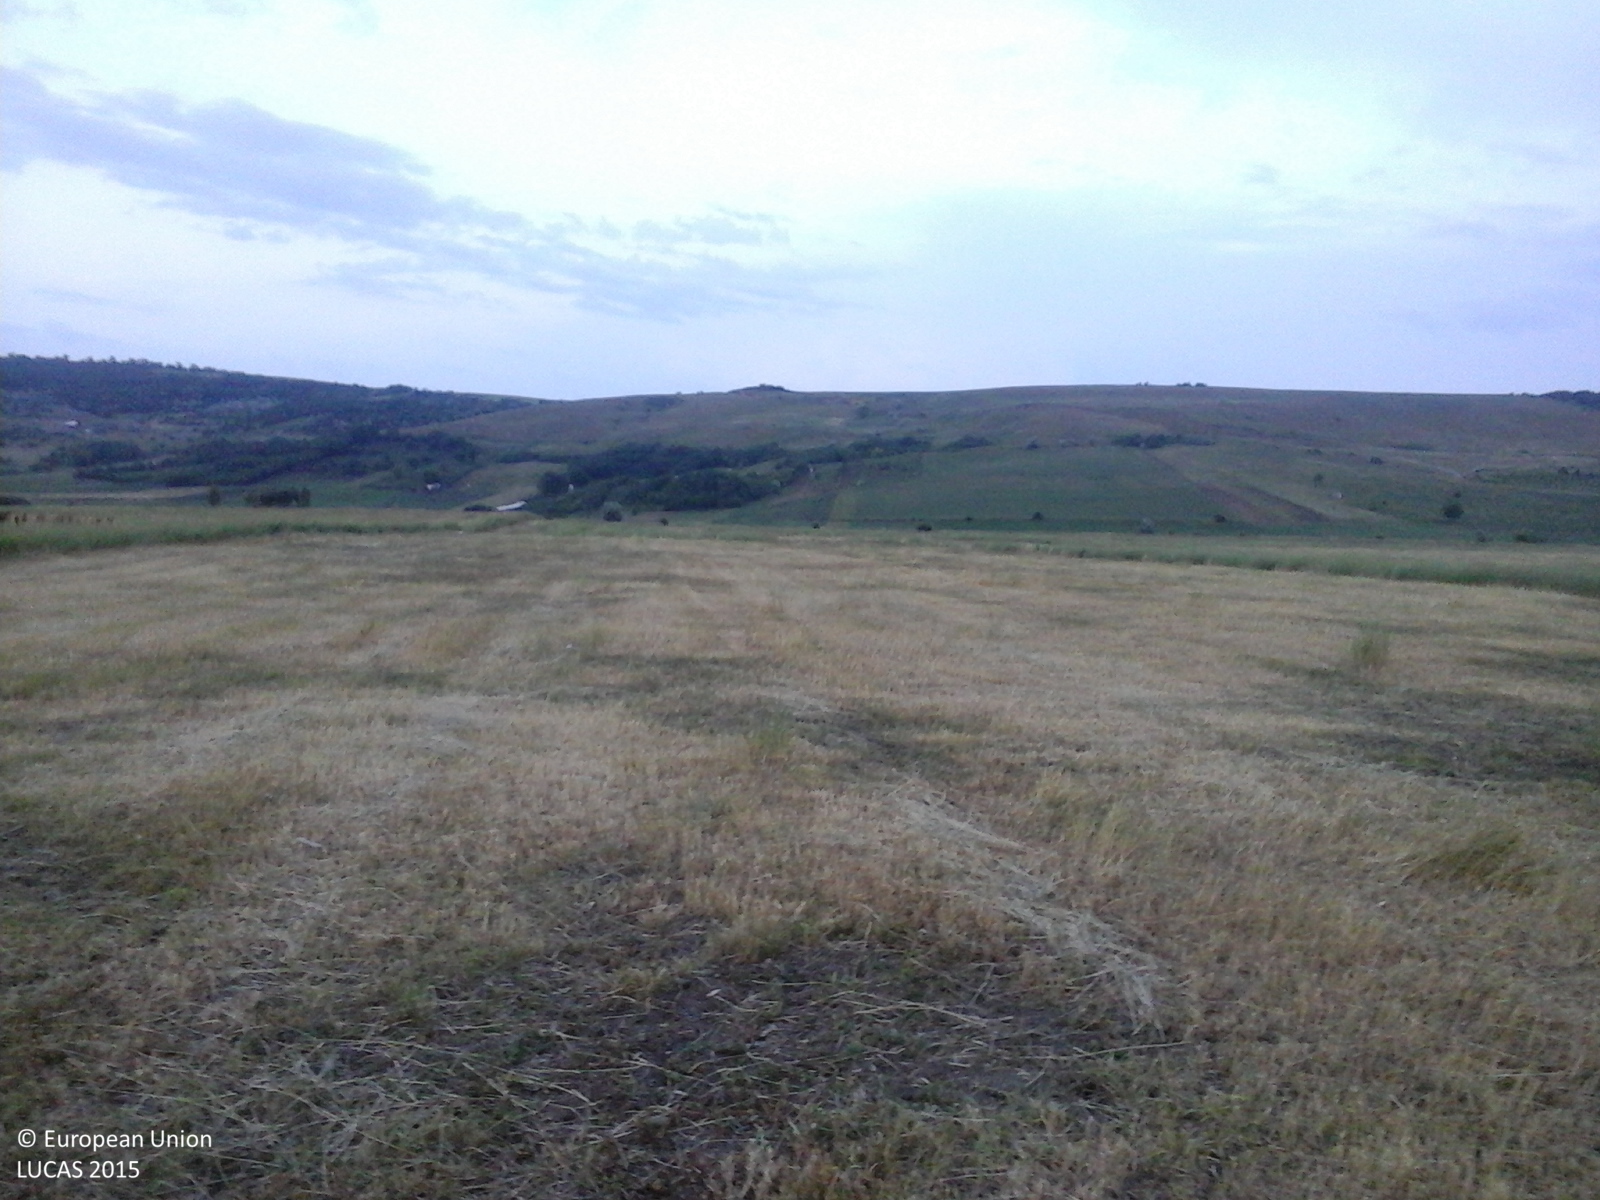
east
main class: Grassland
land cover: Grassland without tree/shrub cover
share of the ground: 10 - 25 %
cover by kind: herbaceous plants 100 %
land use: Agriculture (excluding fallow land and kitchen gardens)
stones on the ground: < 10 %
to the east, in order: Grassland without tree/shrub cover
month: June
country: RO
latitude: 46.6571
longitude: 27.7483
